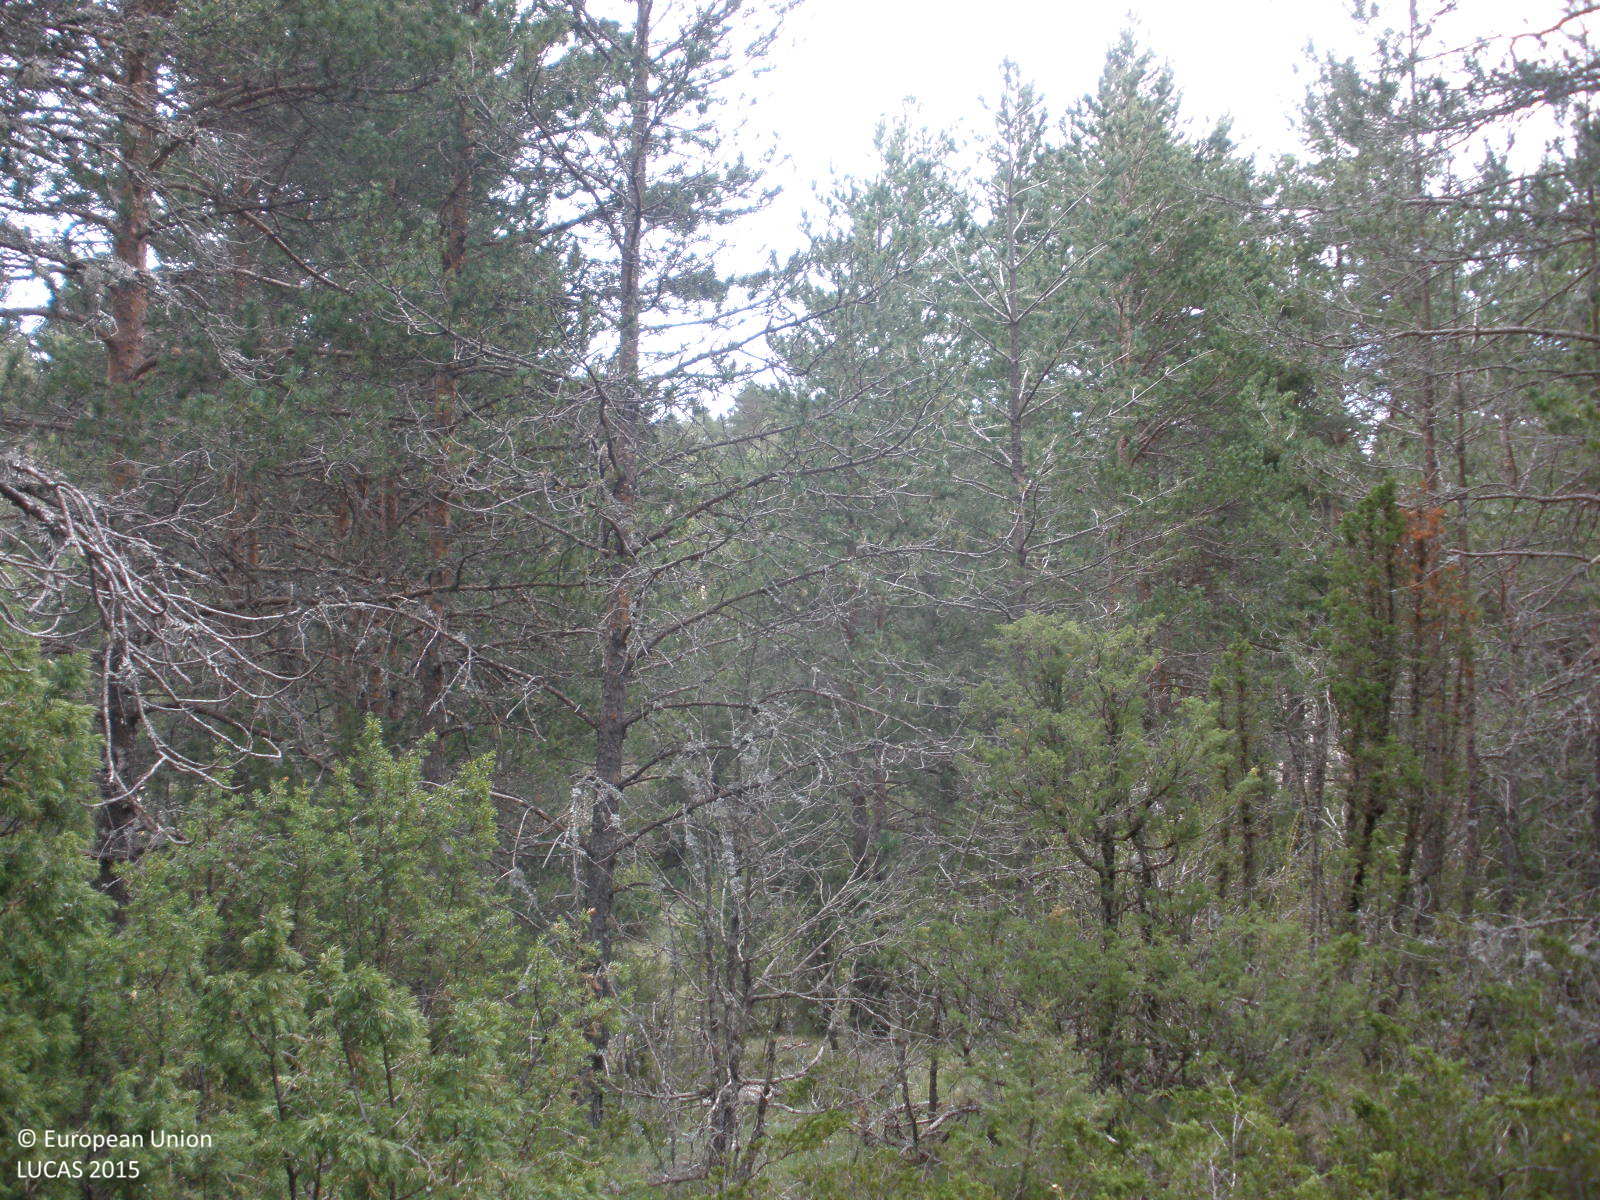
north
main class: Woodland
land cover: Pine dominated coniferous woodland
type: coniferous forest of the mediterranean region
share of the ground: 50 - 75 %
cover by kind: coniferous forest trees 55 %, herbaceous plants 30 %, shrubs 15 %
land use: Semi-natural and natural areas not in use
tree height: > 5 m
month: May
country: ES
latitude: 40.4408
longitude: -0.7494
